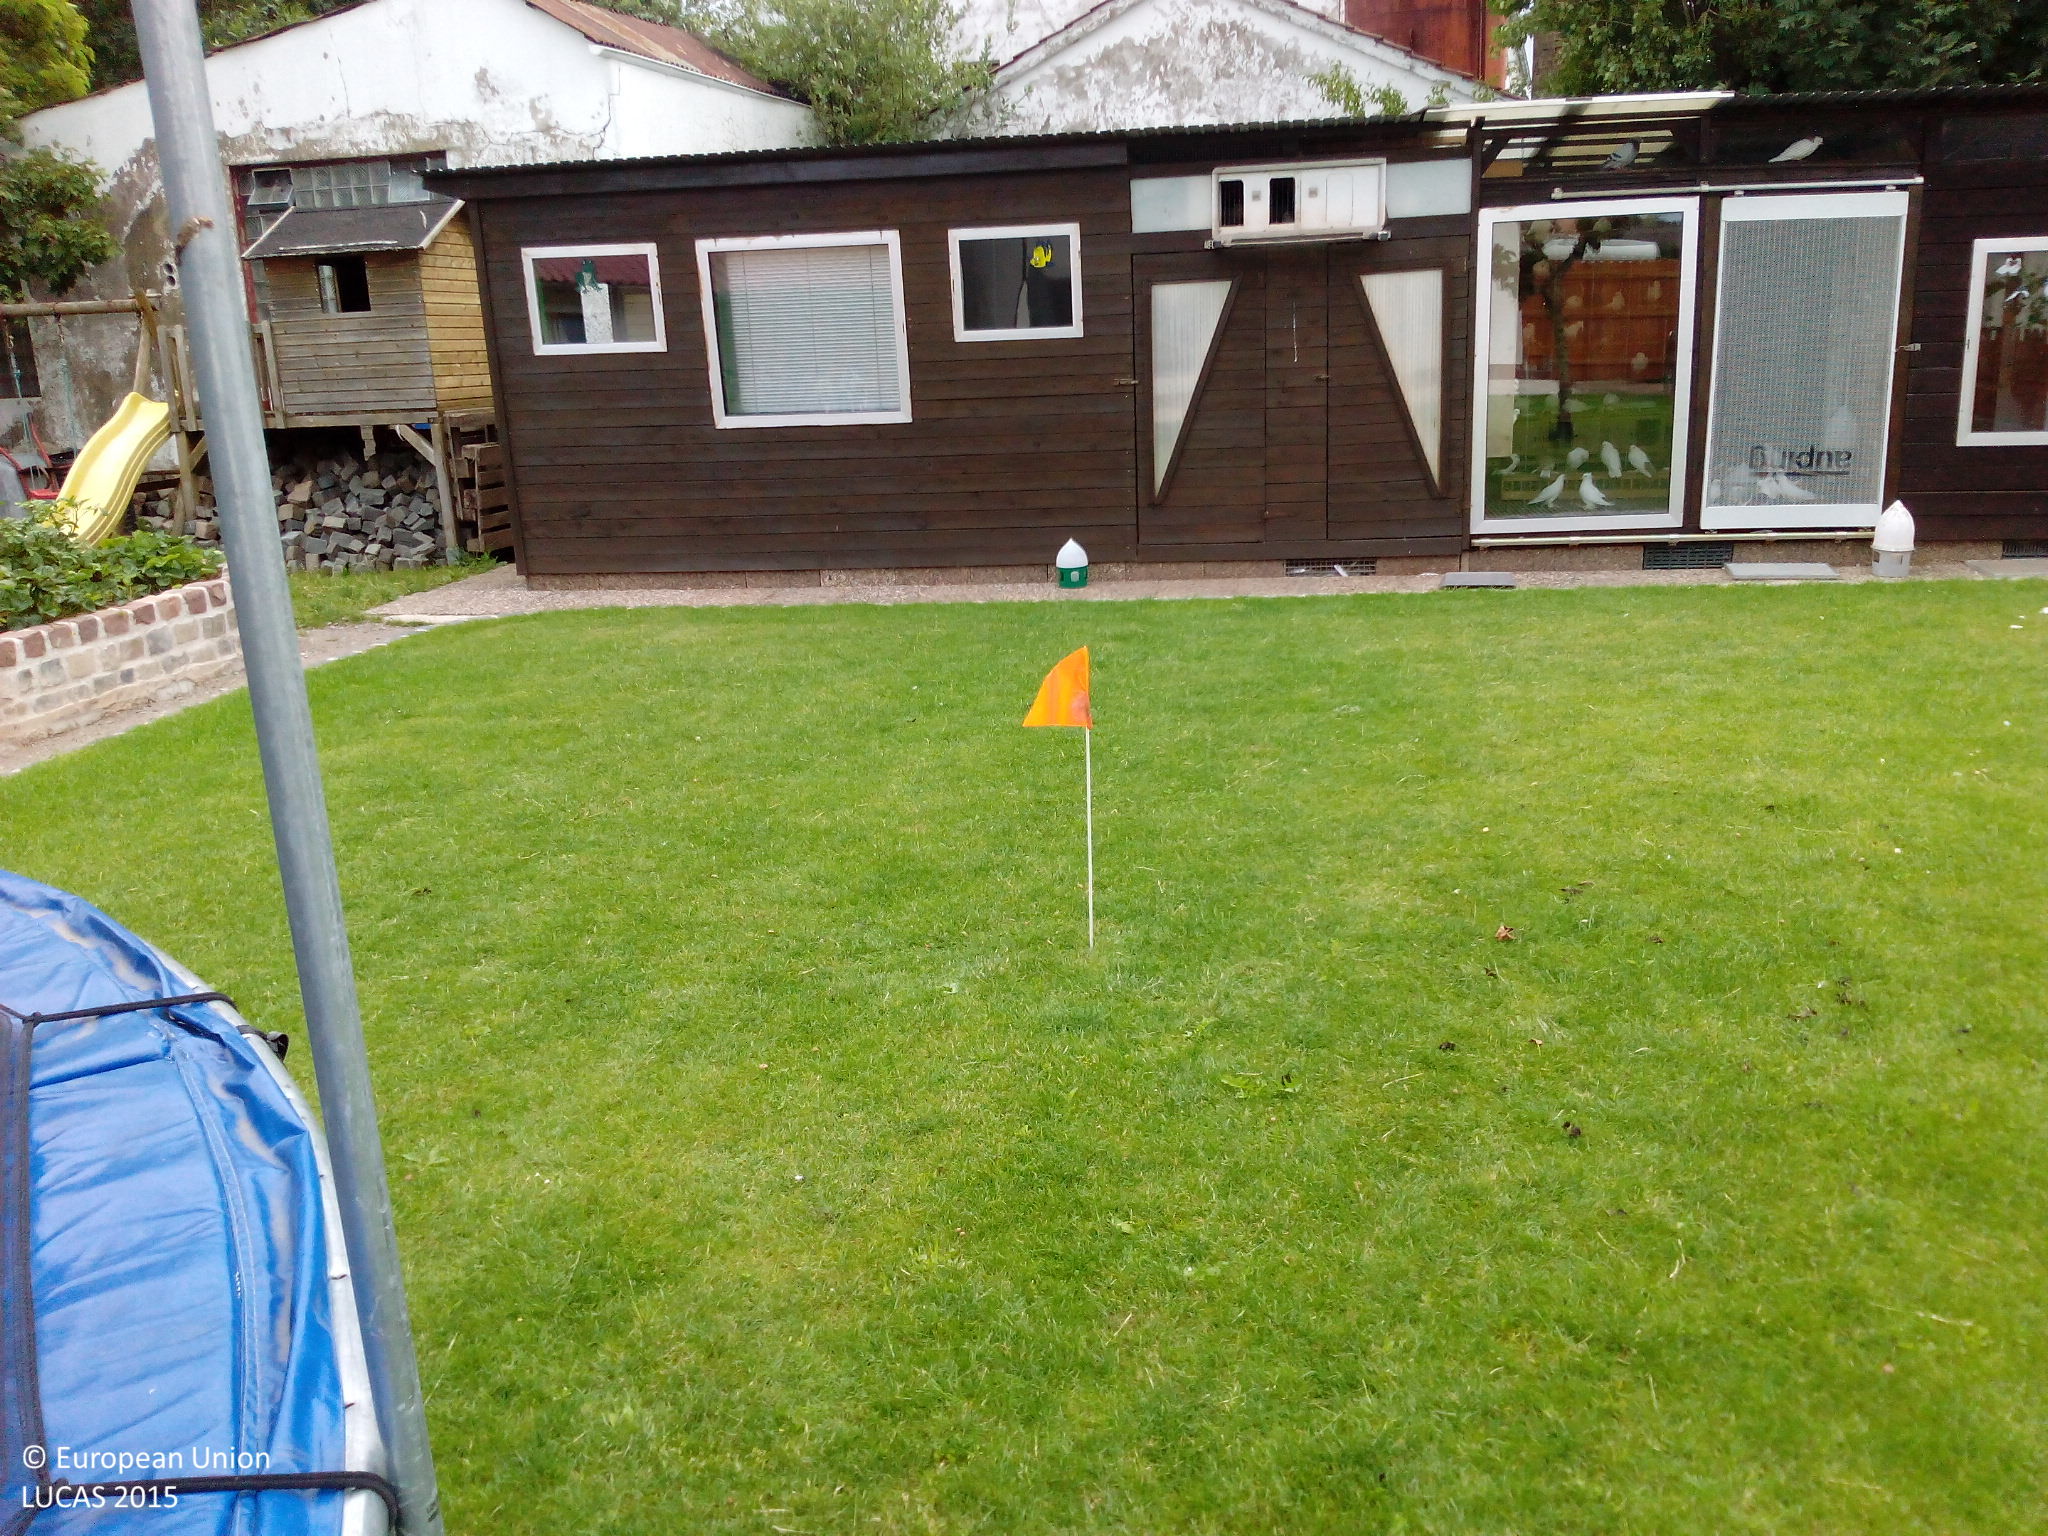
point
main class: Grassland
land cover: Grassland with sparse tree/shrub cover
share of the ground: > 75 %
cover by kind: herbaceous plants 95 %, broadleaved forest trees 5 %
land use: Residential
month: July
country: DE
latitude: 51.5661
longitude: 9.2356
